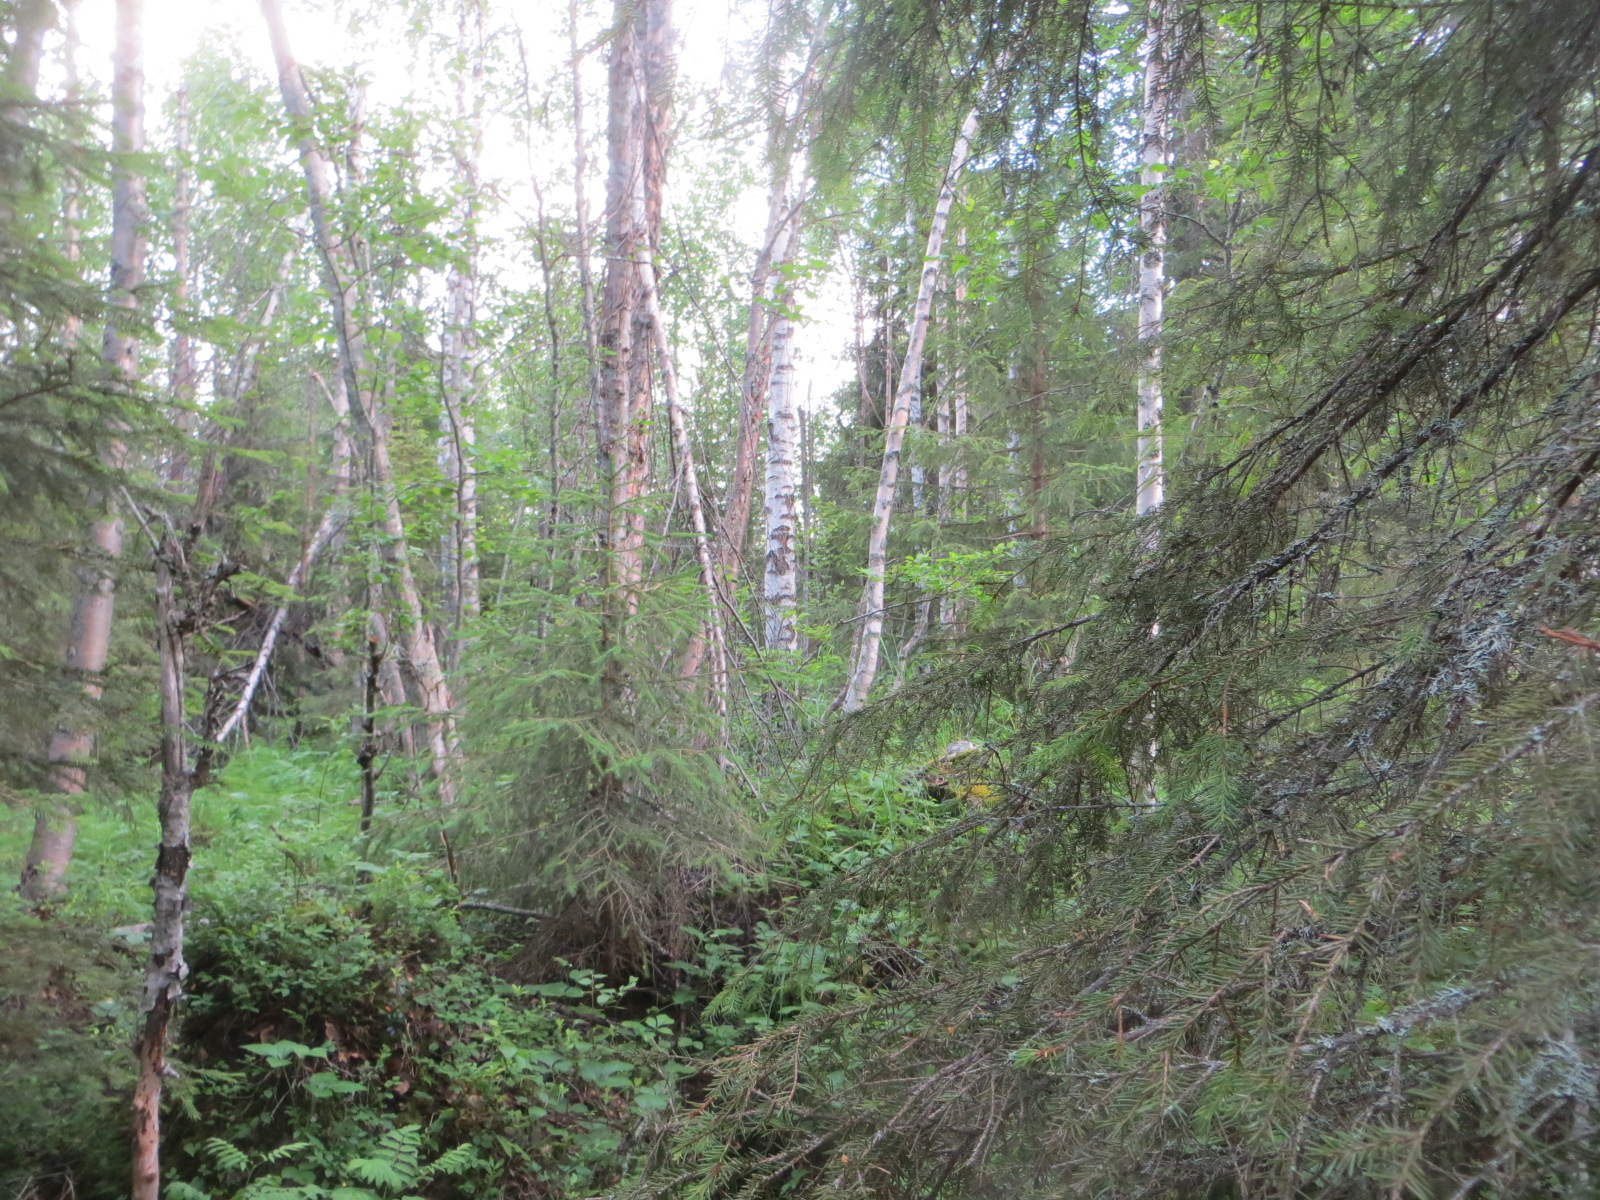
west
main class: Woodland
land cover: Other mixed woodland
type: boreal forest
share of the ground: 50 - 75 %
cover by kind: coniferous forest trees 40 %, broadleaved forest trees 30 %, shrubs 20 %, herbaceous plants 10 %
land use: Forestry
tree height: > 5 m
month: July
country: FI
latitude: 66.3127
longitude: 24.4791
